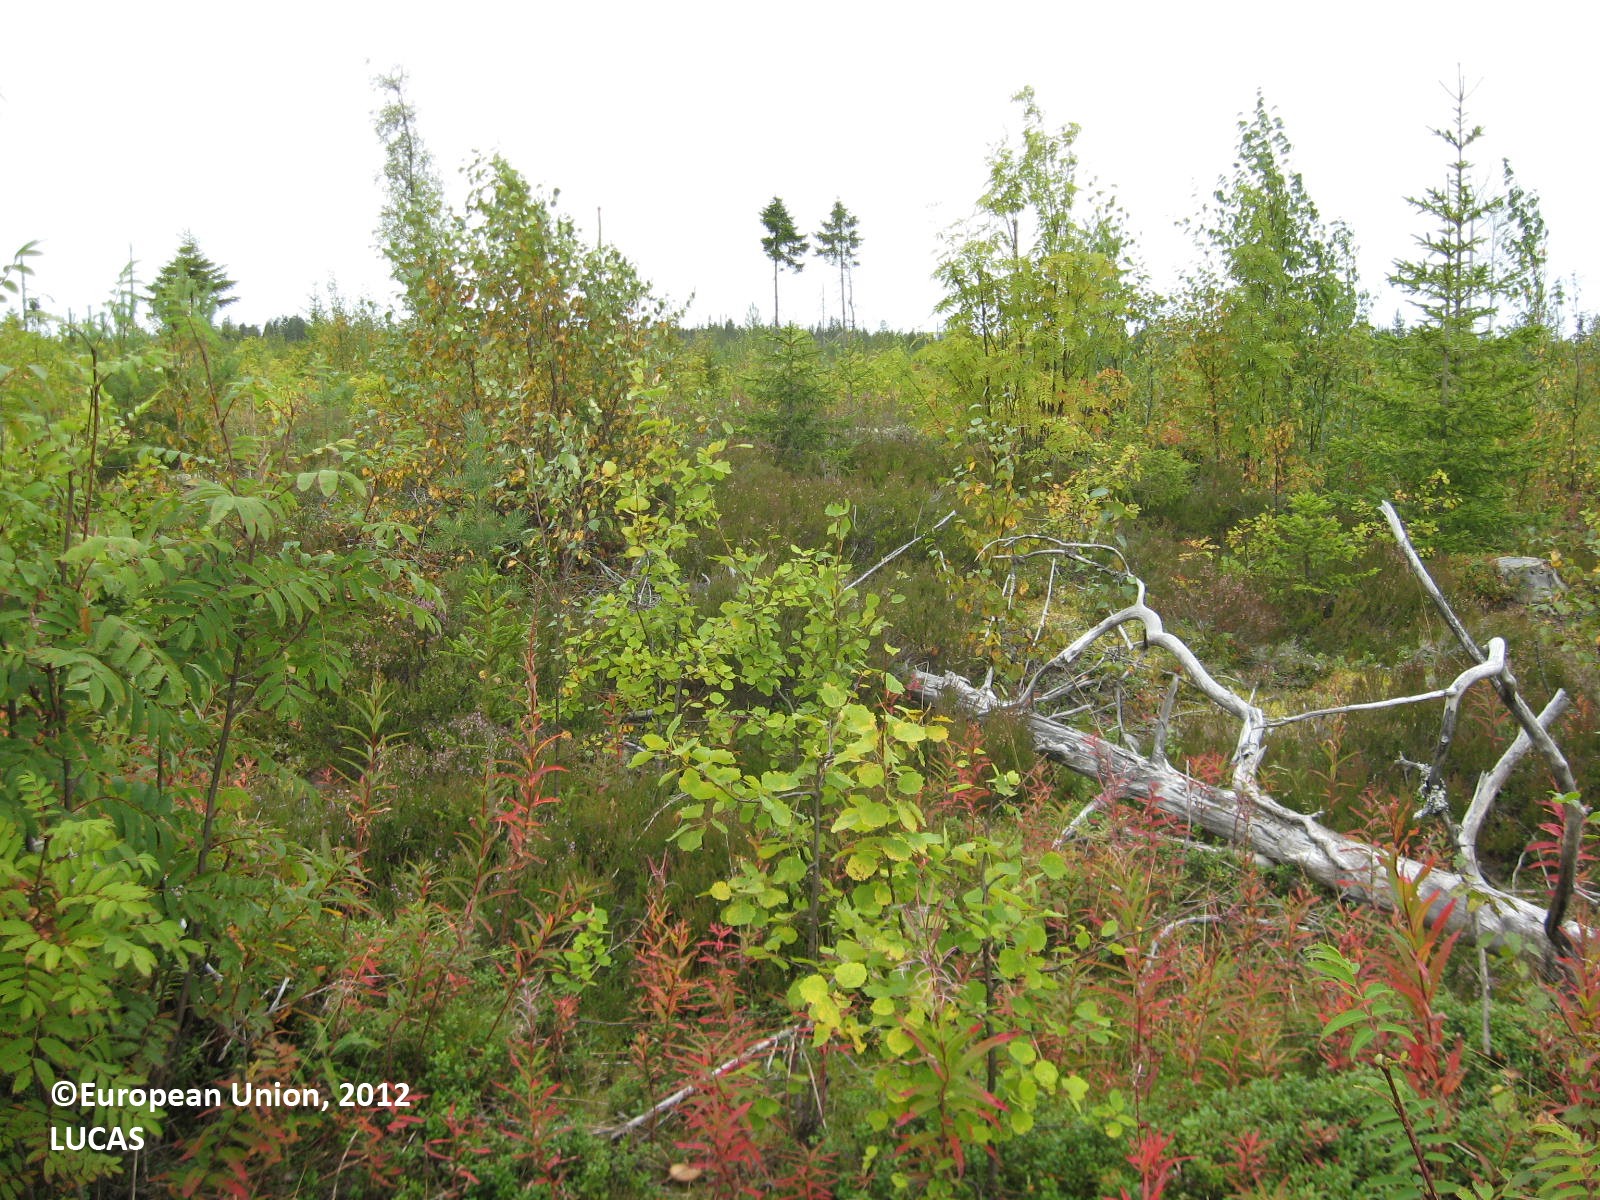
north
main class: Woodland
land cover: Other mixed woodland
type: boreal forest
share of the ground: 50 - 75 %
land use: Forestry
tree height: < 5 m
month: August
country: FI
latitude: 63.8895
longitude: 29.4236
